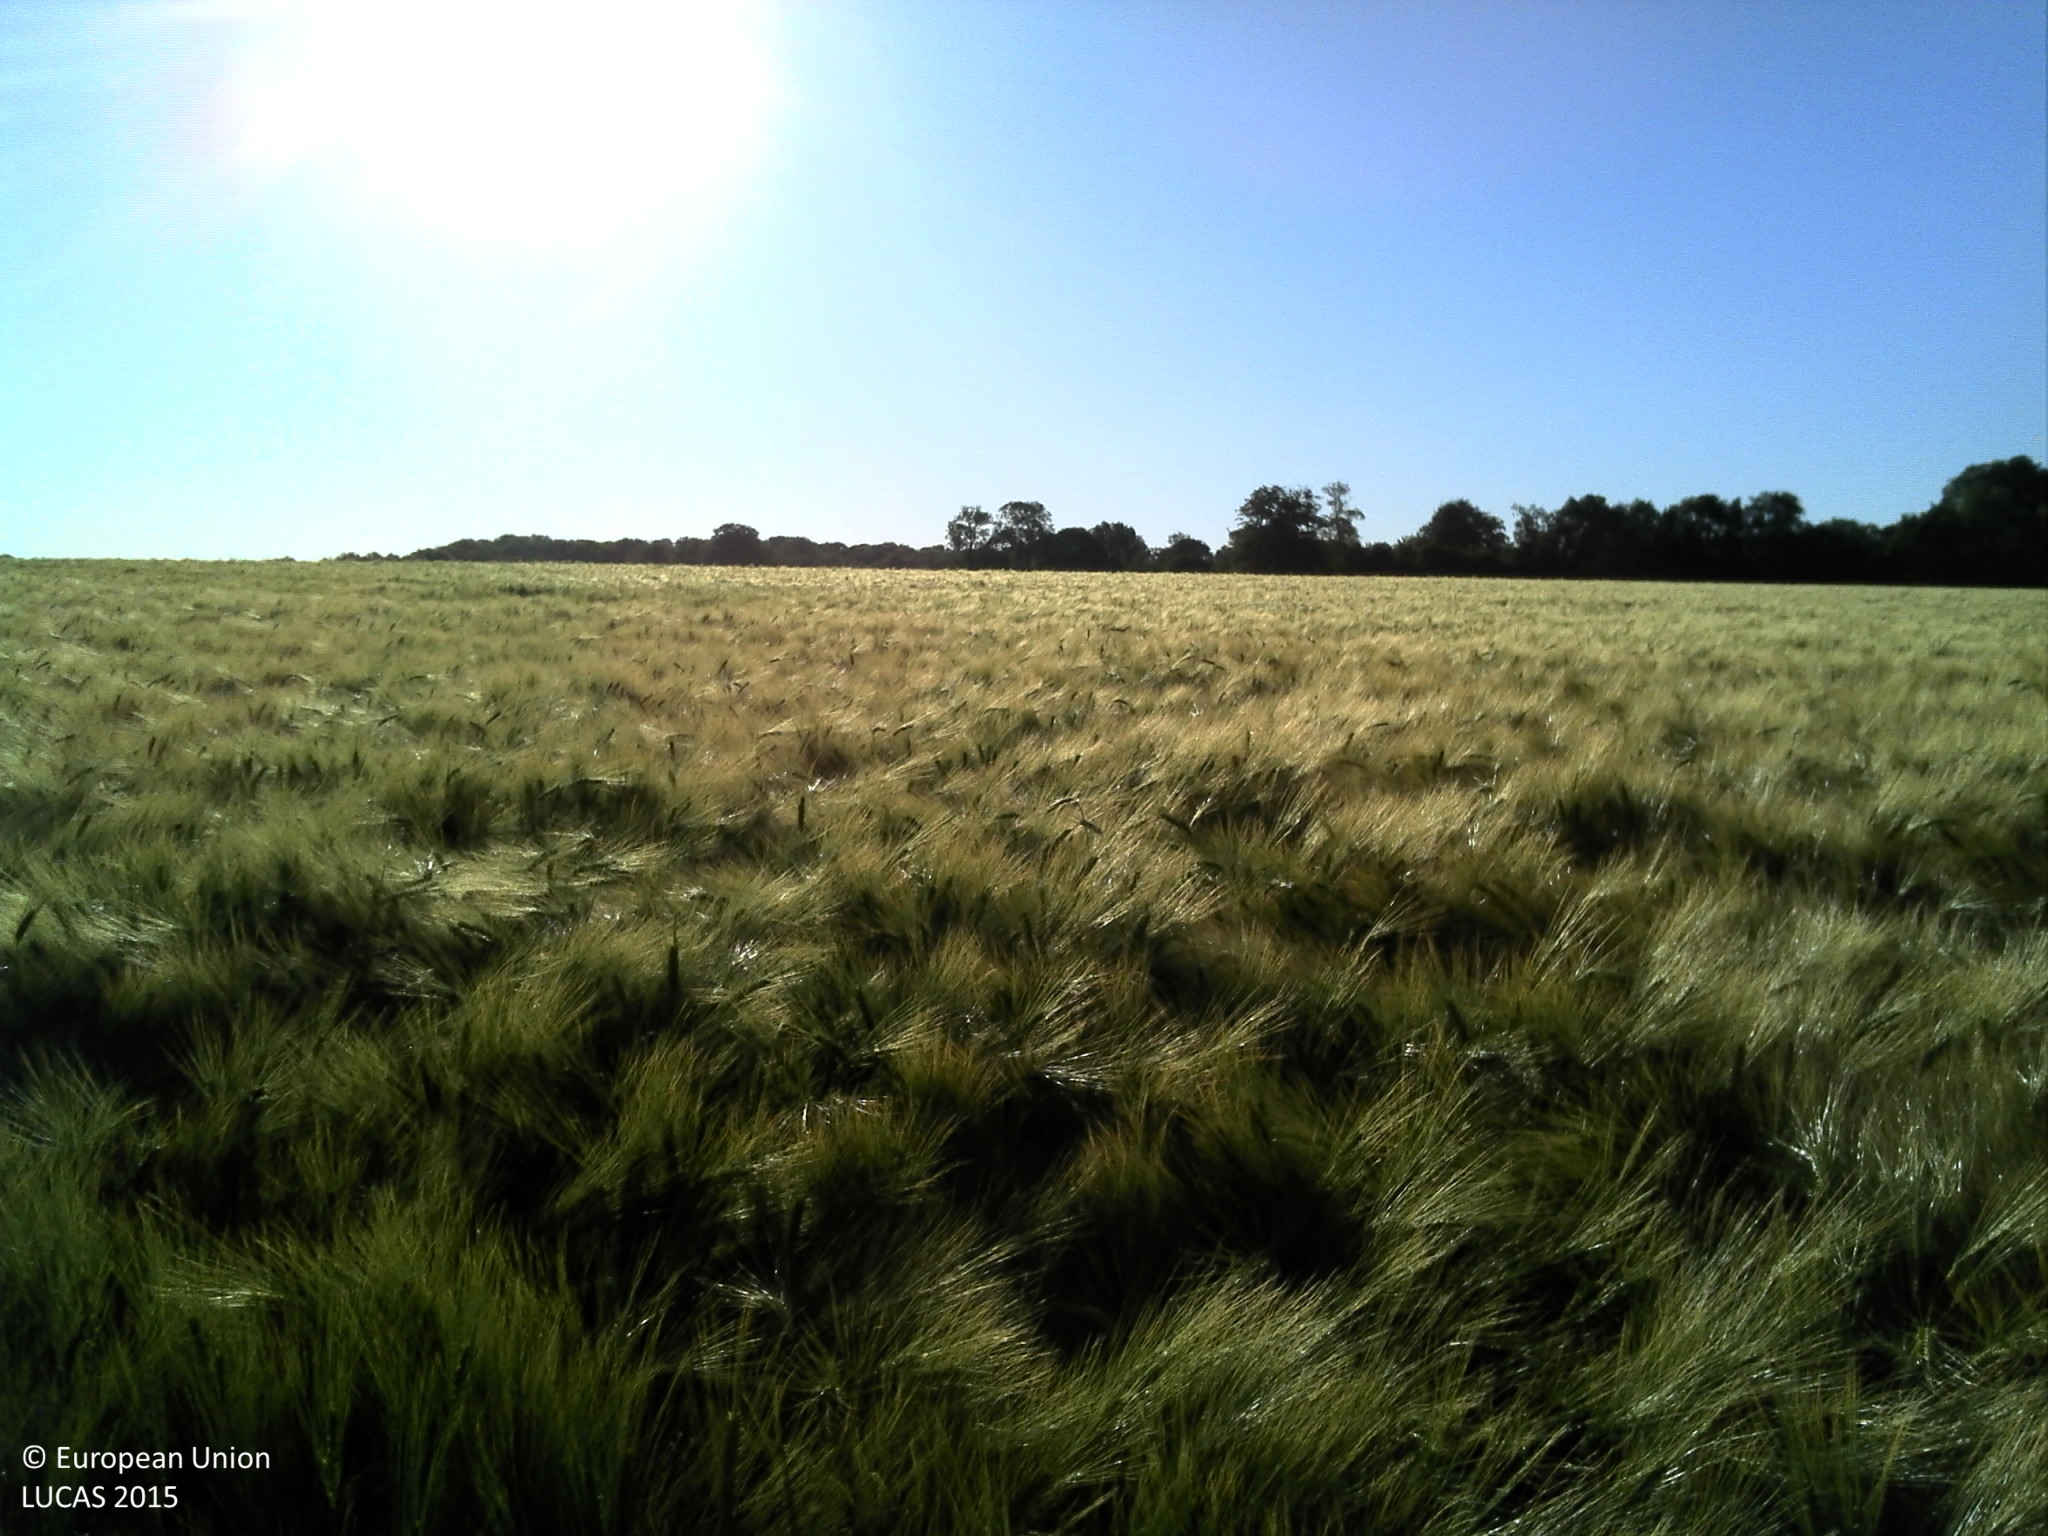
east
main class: Cropland
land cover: Common wheat
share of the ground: > 75 %
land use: Agriculture (excluding fallow land and kitchen gardens)
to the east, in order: Barley
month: June
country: FR
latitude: 49.6102
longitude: 0.9959
